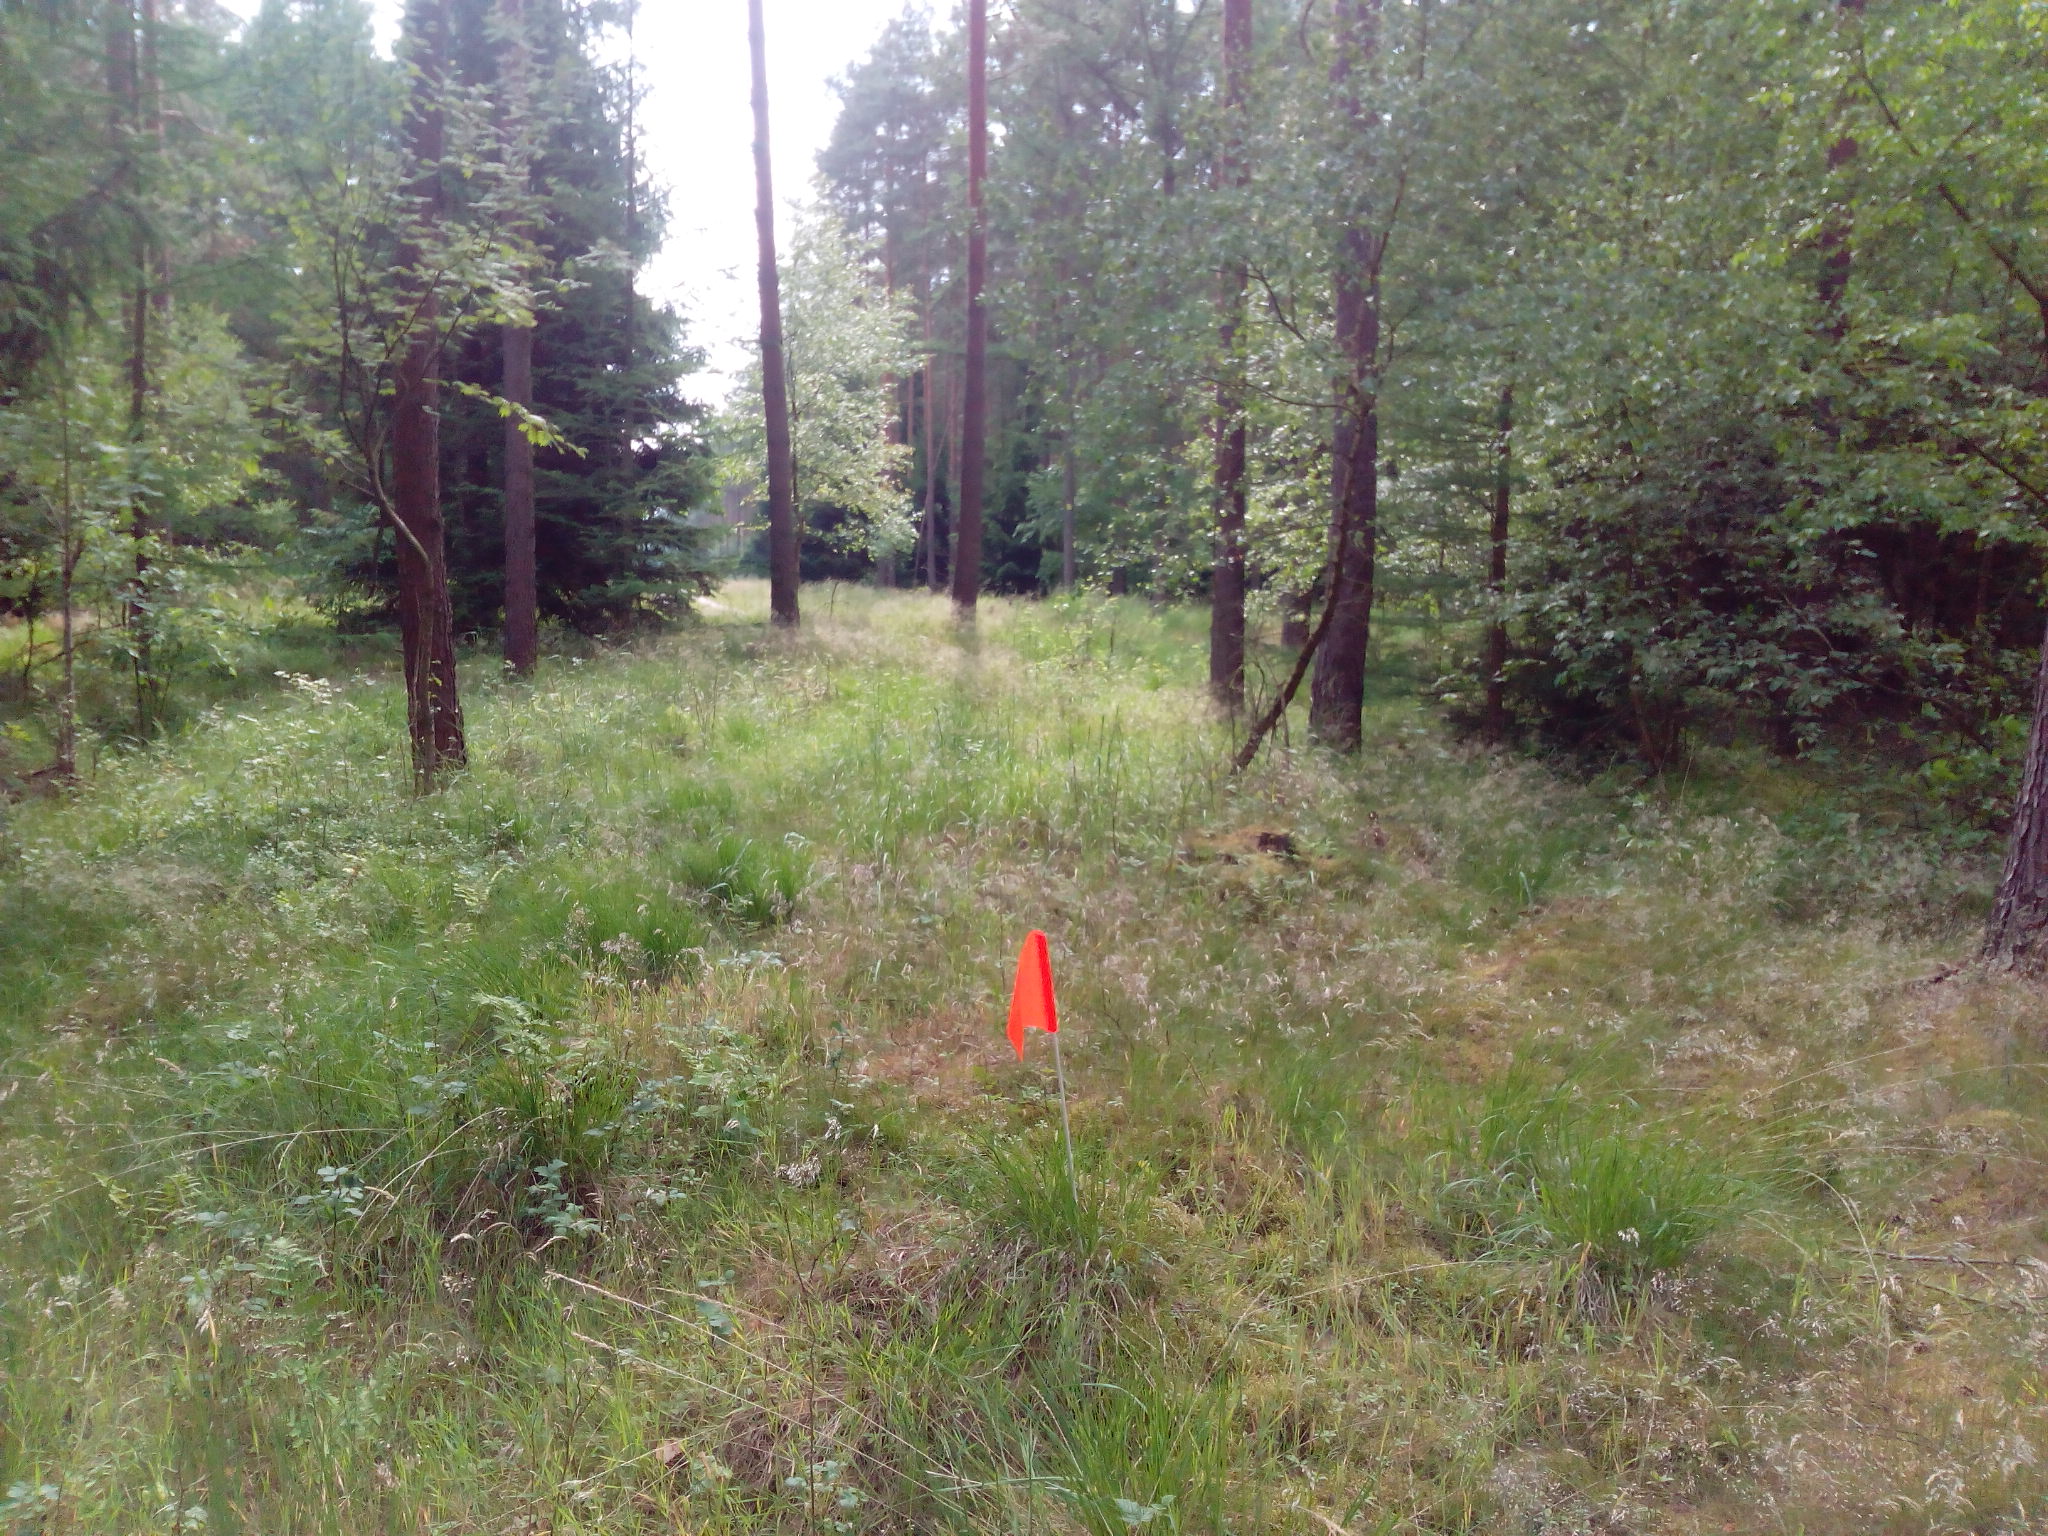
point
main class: Woodland
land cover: Pine dominated coniferous woodland
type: hemiboreal forest and nemoral coniferous forest and mixed broadleaved-coniferous forest
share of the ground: > 75 %
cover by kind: coniferous forest trees 75 %, herbaceous plants 15 %, broadleaved forest trees 5 %, shrubs 5 %
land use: Forestry
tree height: > 5 m
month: June
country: DE
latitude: 52.6290
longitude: 9.8966
